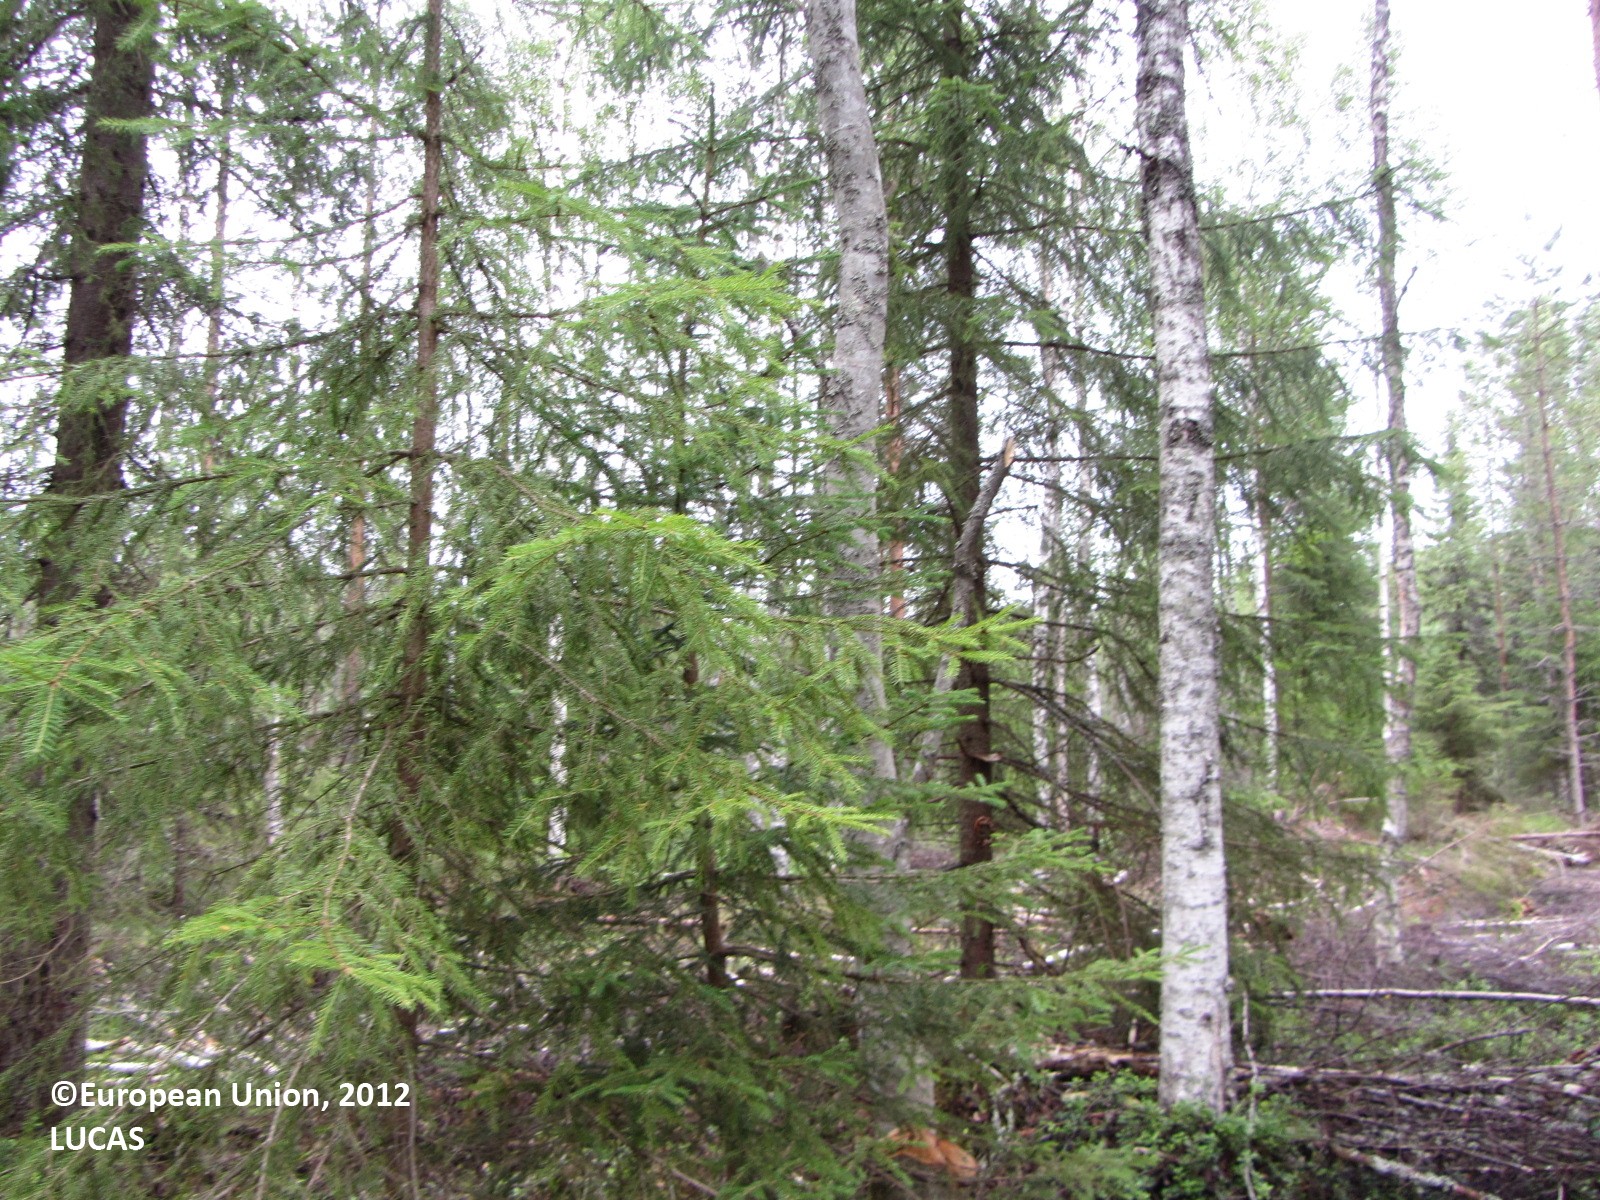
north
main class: Woodland
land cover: Other mixed woodland
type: boreal forest
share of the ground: 50 - 75 %
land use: Forestry
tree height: > 5 m
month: July
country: FI
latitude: 63.8905
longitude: 24.7236
